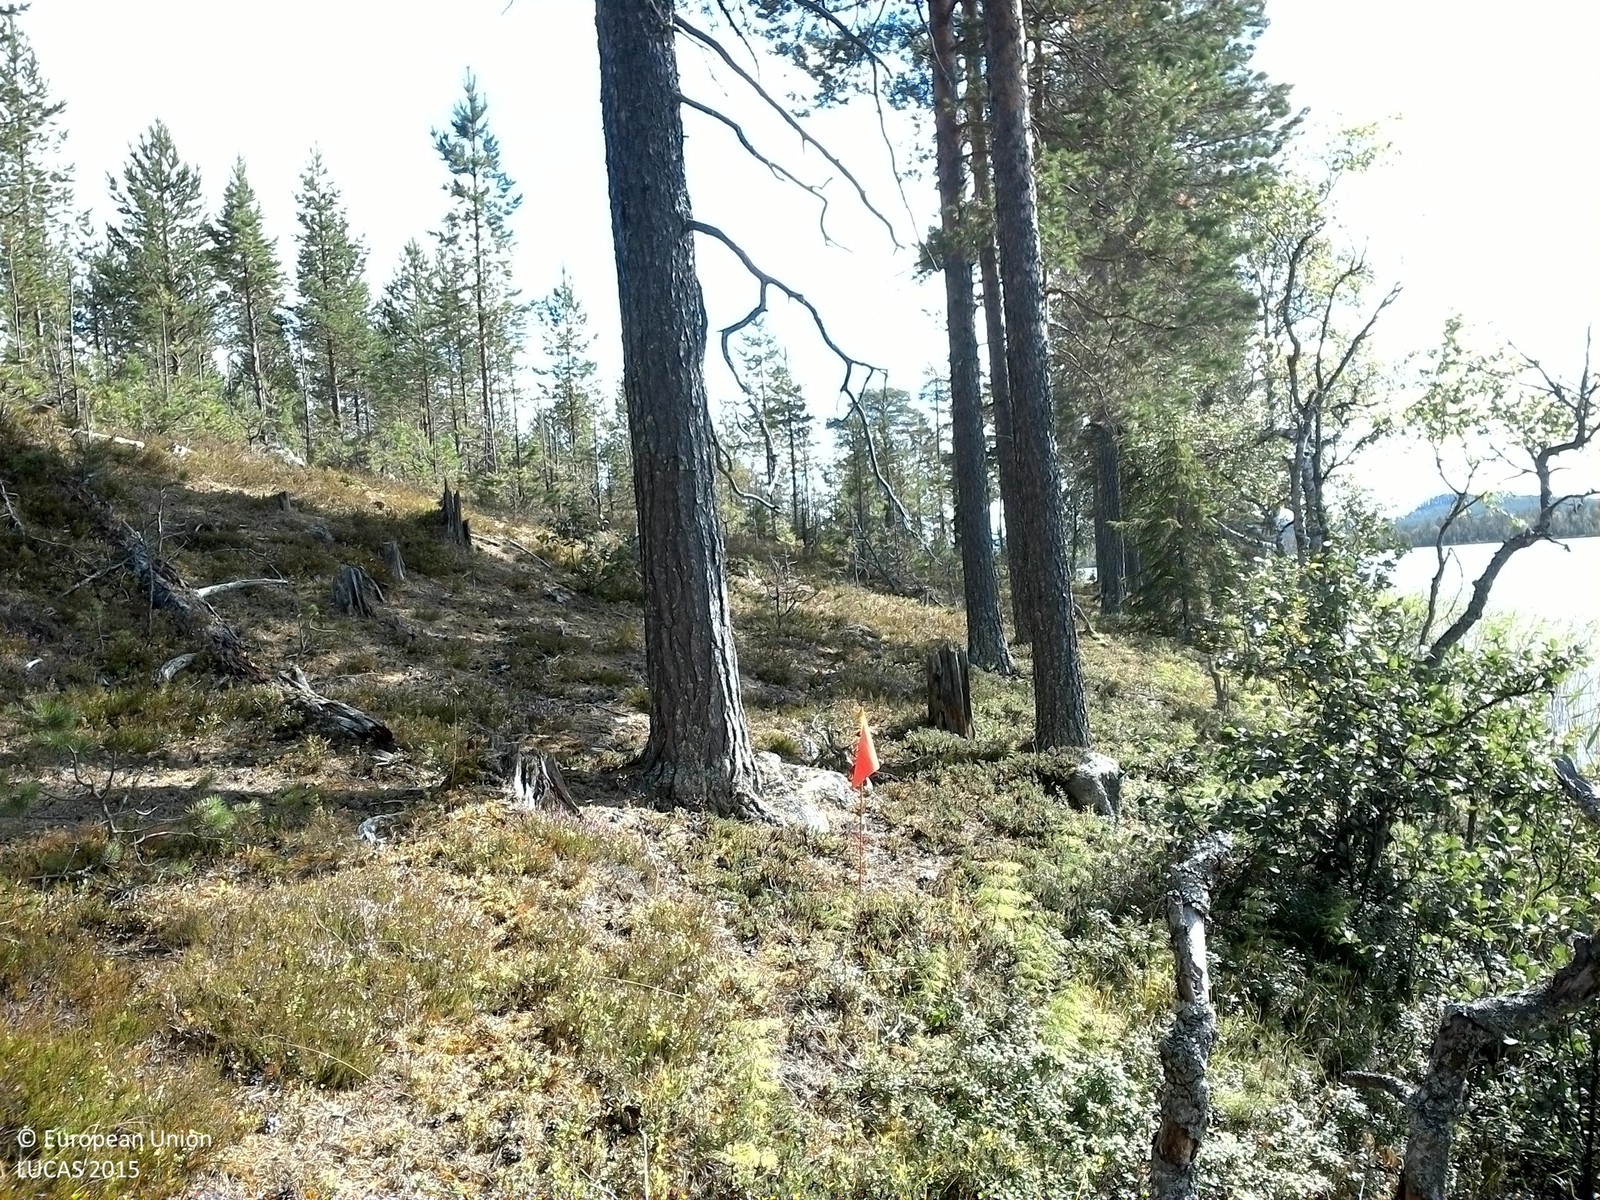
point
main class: Woodland
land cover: Pine dominated coniferous woodland
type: boreal forest
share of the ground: 25 - 50 %
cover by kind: shrubs 40 %, coniferous forest trees 35 %, lichens and mosses 25 %
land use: Forestry
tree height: > 5 m
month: August
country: SE
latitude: 64.0521
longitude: 17.6109
